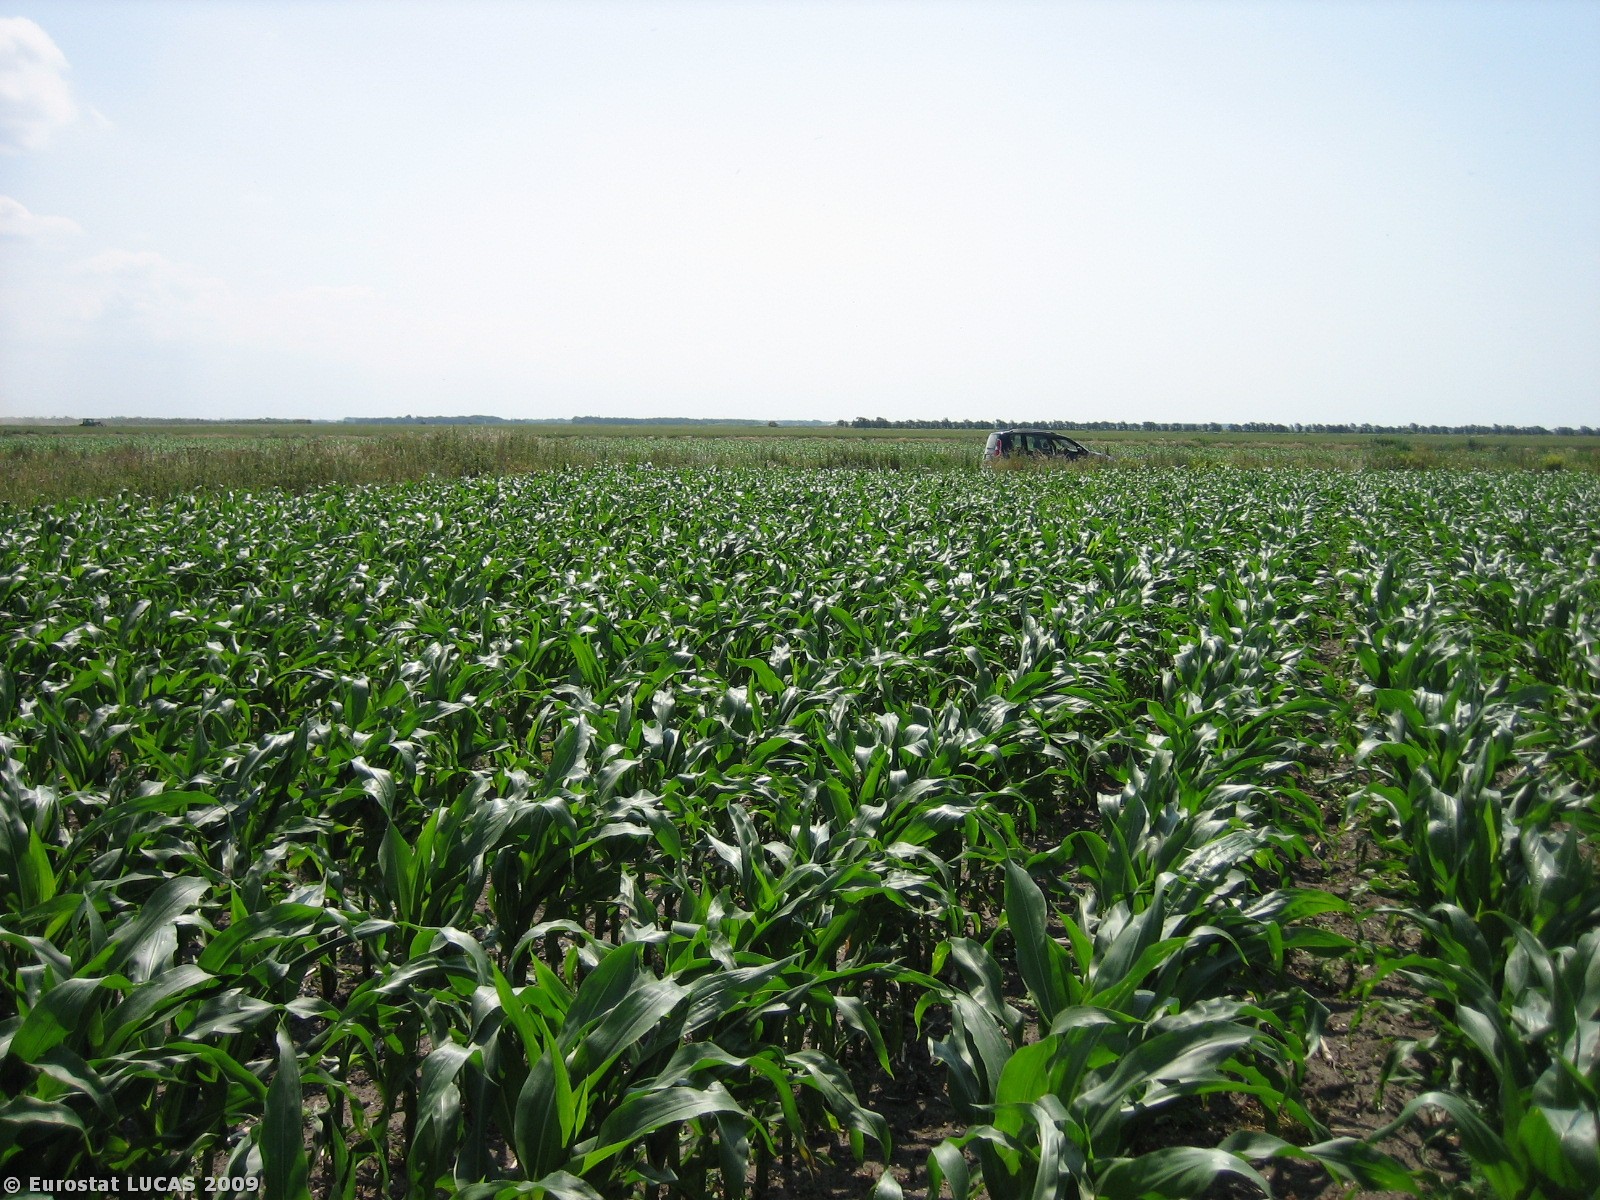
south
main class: Cropland
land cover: Maize
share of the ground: 50 - 75 %
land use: Agriculture (excluding fallow land and kitchen gardens)
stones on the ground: < 10 %
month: July
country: DK
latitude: 55.3545
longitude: 8.7235
